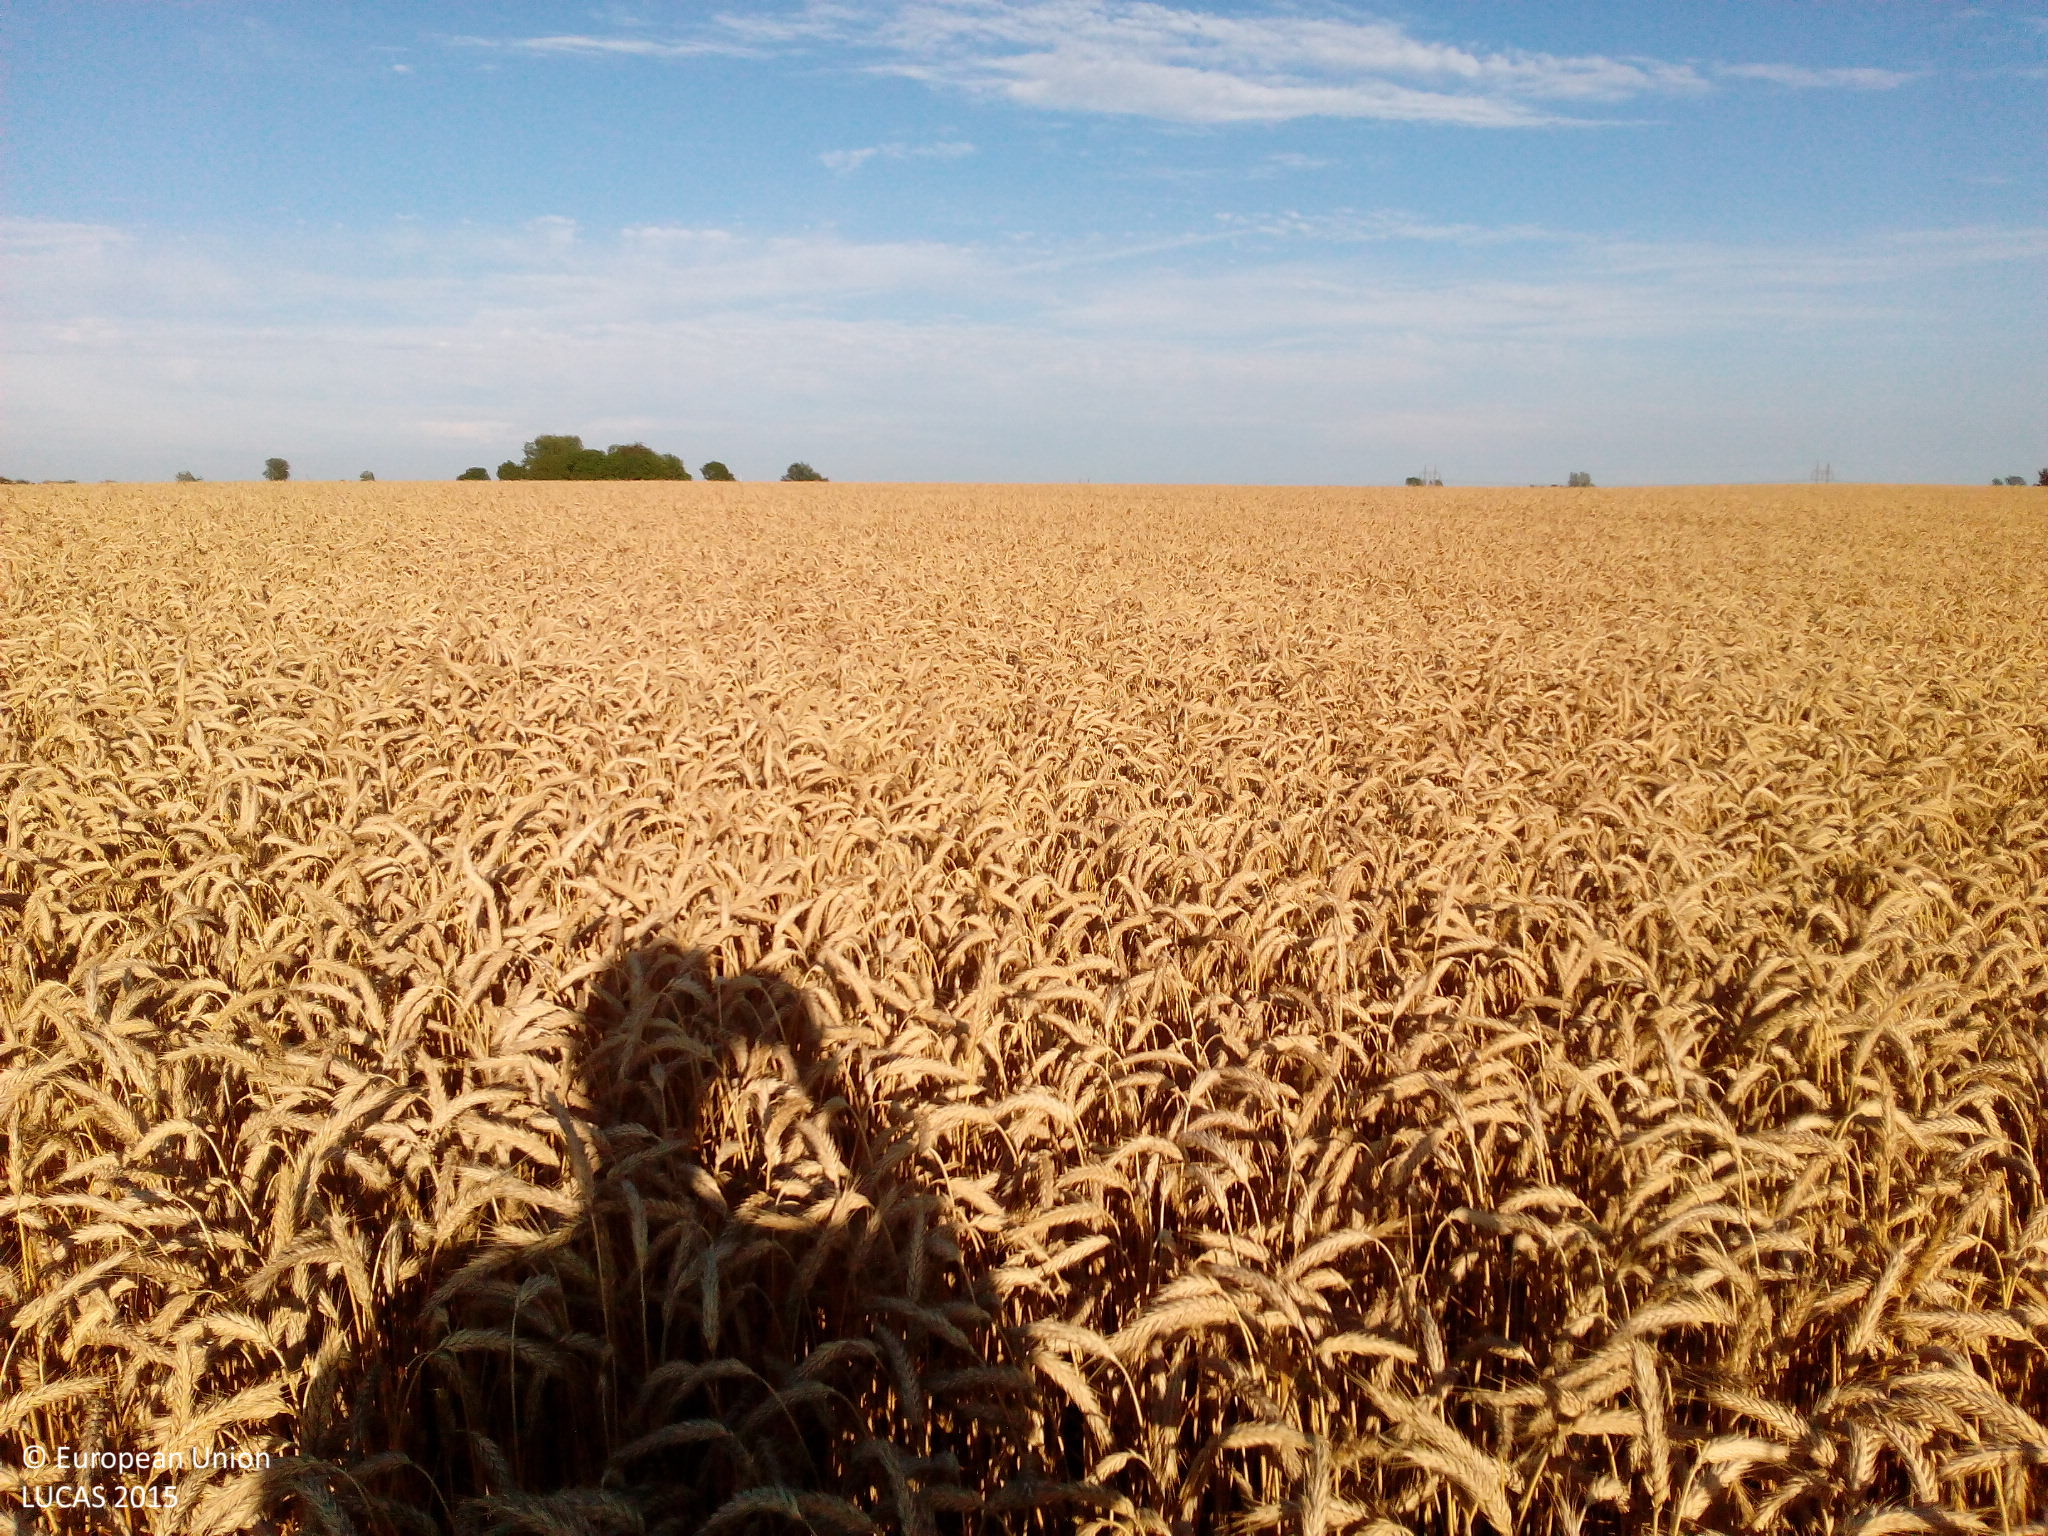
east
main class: Cropland
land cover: Common wheat
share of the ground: > 75 %
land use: Agriculture (excluding fallow land and kitchen gardens)
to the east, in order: Common wheat
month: August
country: DK
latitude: 55.5648
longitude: 11.7269
